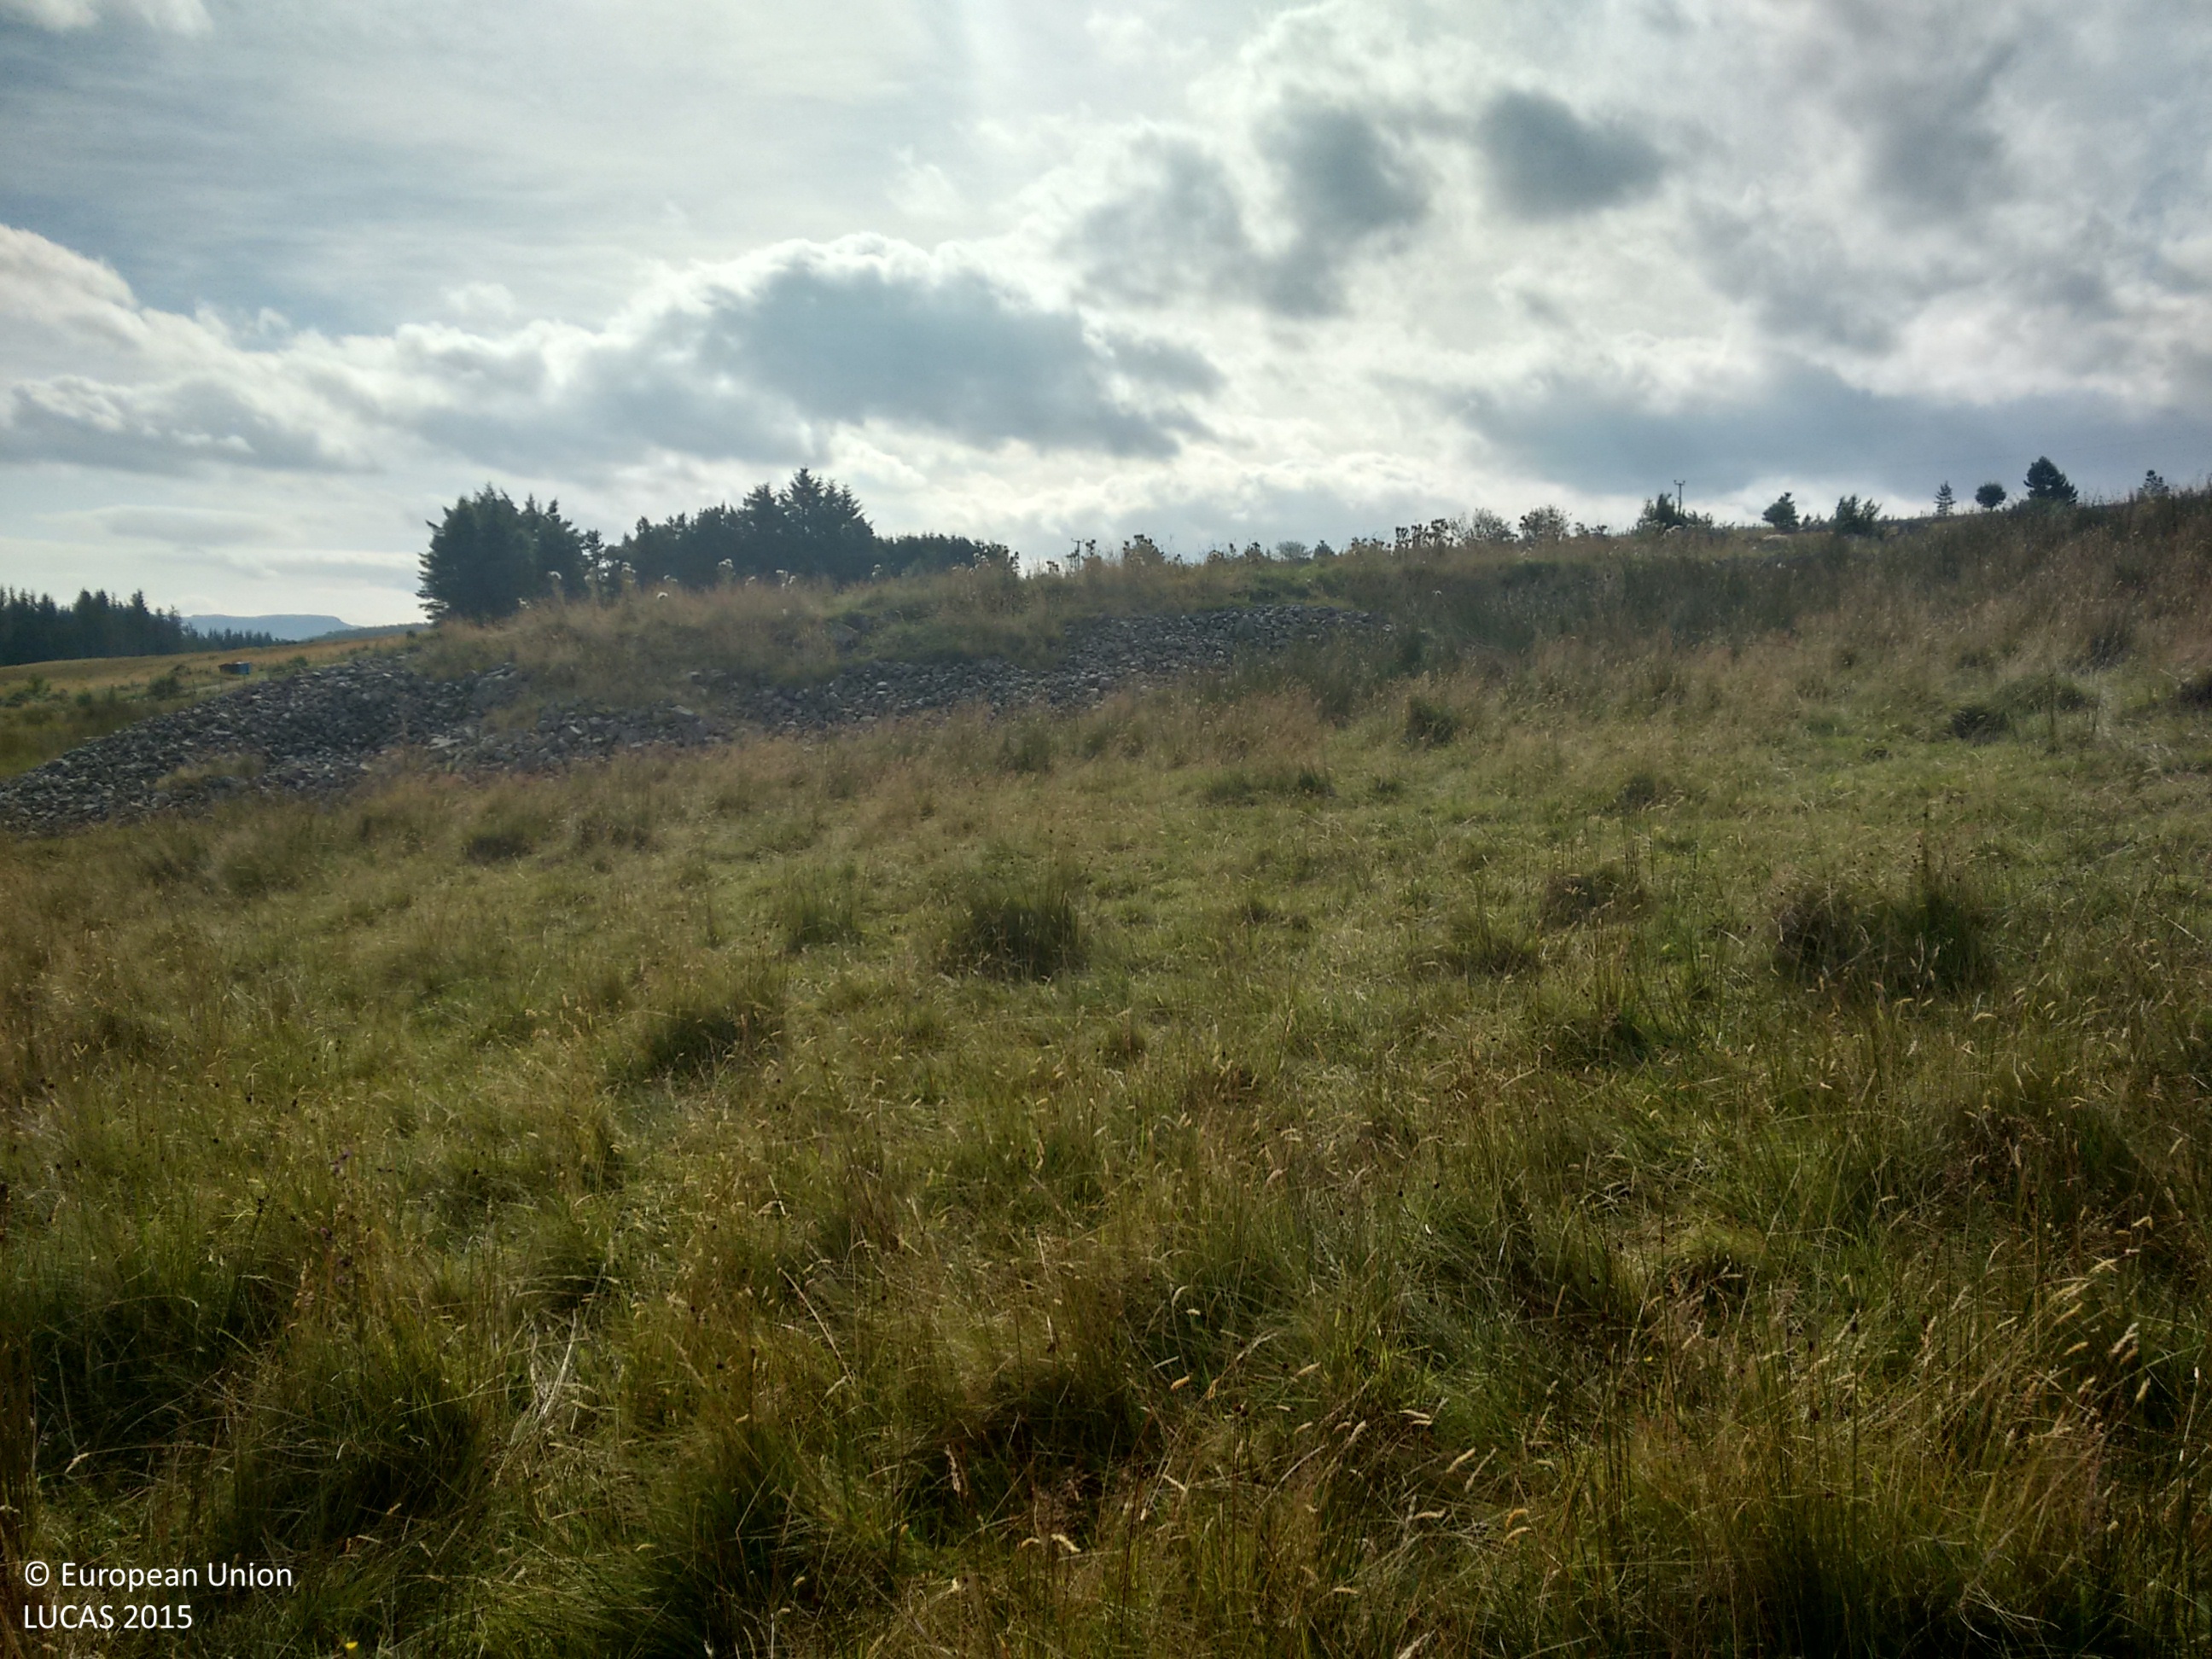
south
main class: Grassland
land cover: Grassland without tree/shrub cover
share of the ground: > 75 %
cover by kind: herbaceous plants 100 %
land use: Agriculture (excluding fallow land and kitchen gardens)
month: September
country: GB
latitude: 57.9127
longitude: -4.4164
